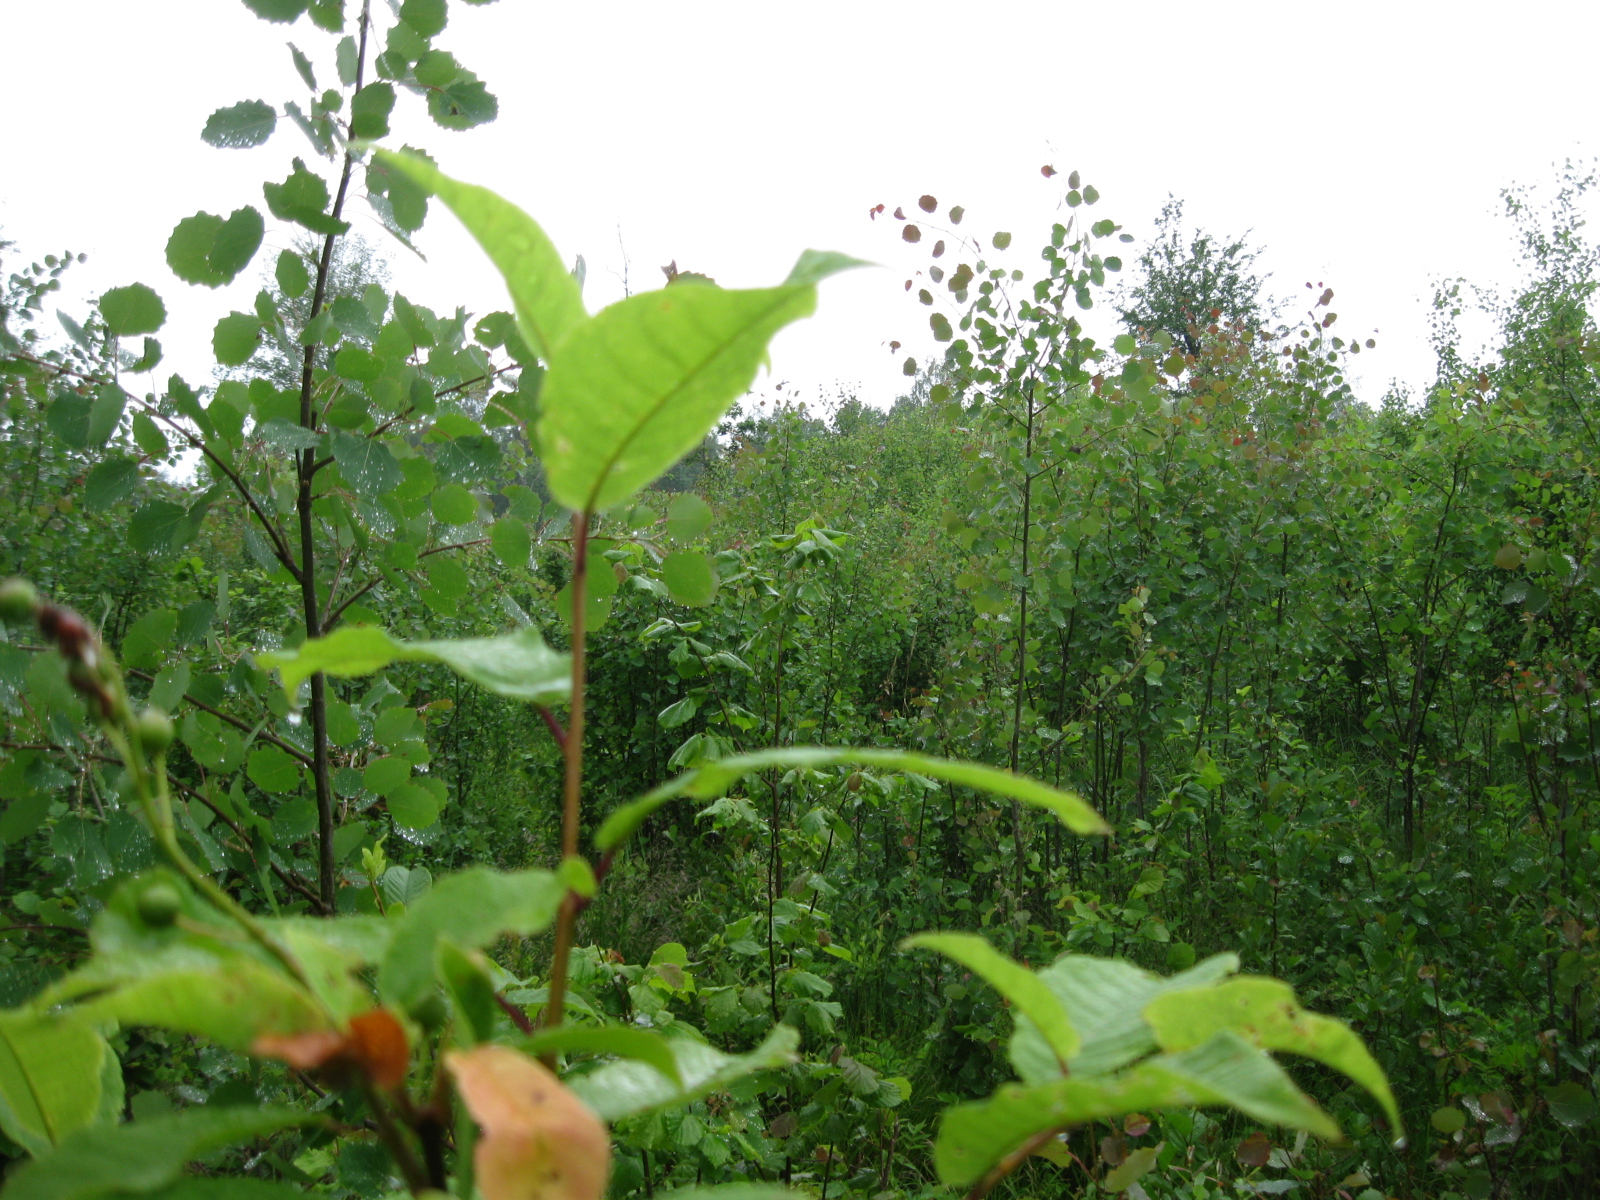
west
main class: Woodland
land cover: Broadleaved woodland
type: non-riverine alder, birch or aspen forest
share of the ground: > 75 %
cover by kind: broadleaved forest trees 80 %, herbaceous plants 15 %, shrubs 5 %
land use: Forestry
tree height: < 5 m
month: June
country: LT
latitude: 55.6532
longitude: 23.9945
